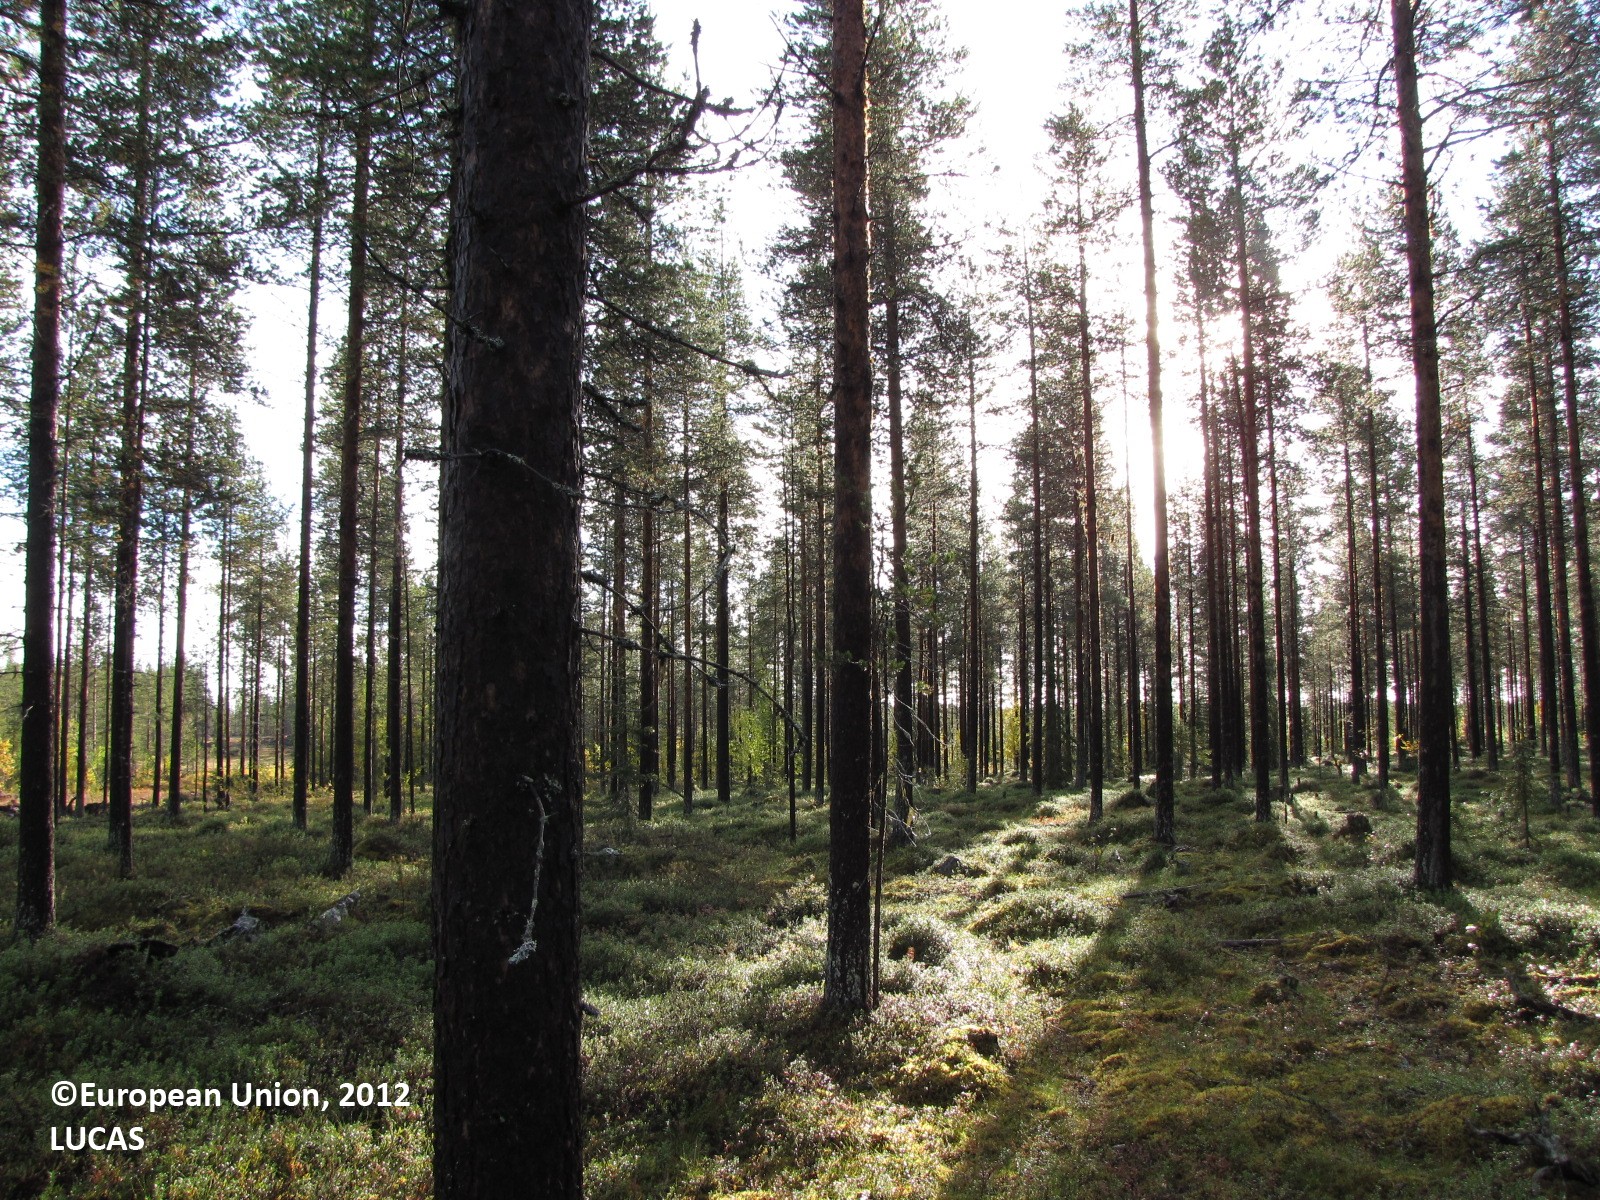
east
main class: Woodland
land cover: Pine dominated coniferous woodland
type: boreal forest
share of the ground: 50 - 75 %
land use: Forestry
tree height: > 5 m
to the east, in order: Pine dominated coniferous woodland; Pine dominated mixed woodland; Peatbogs; Pine dominated coniferous woodland
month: September
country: FI
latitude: 67.2491
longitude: 25.4142
